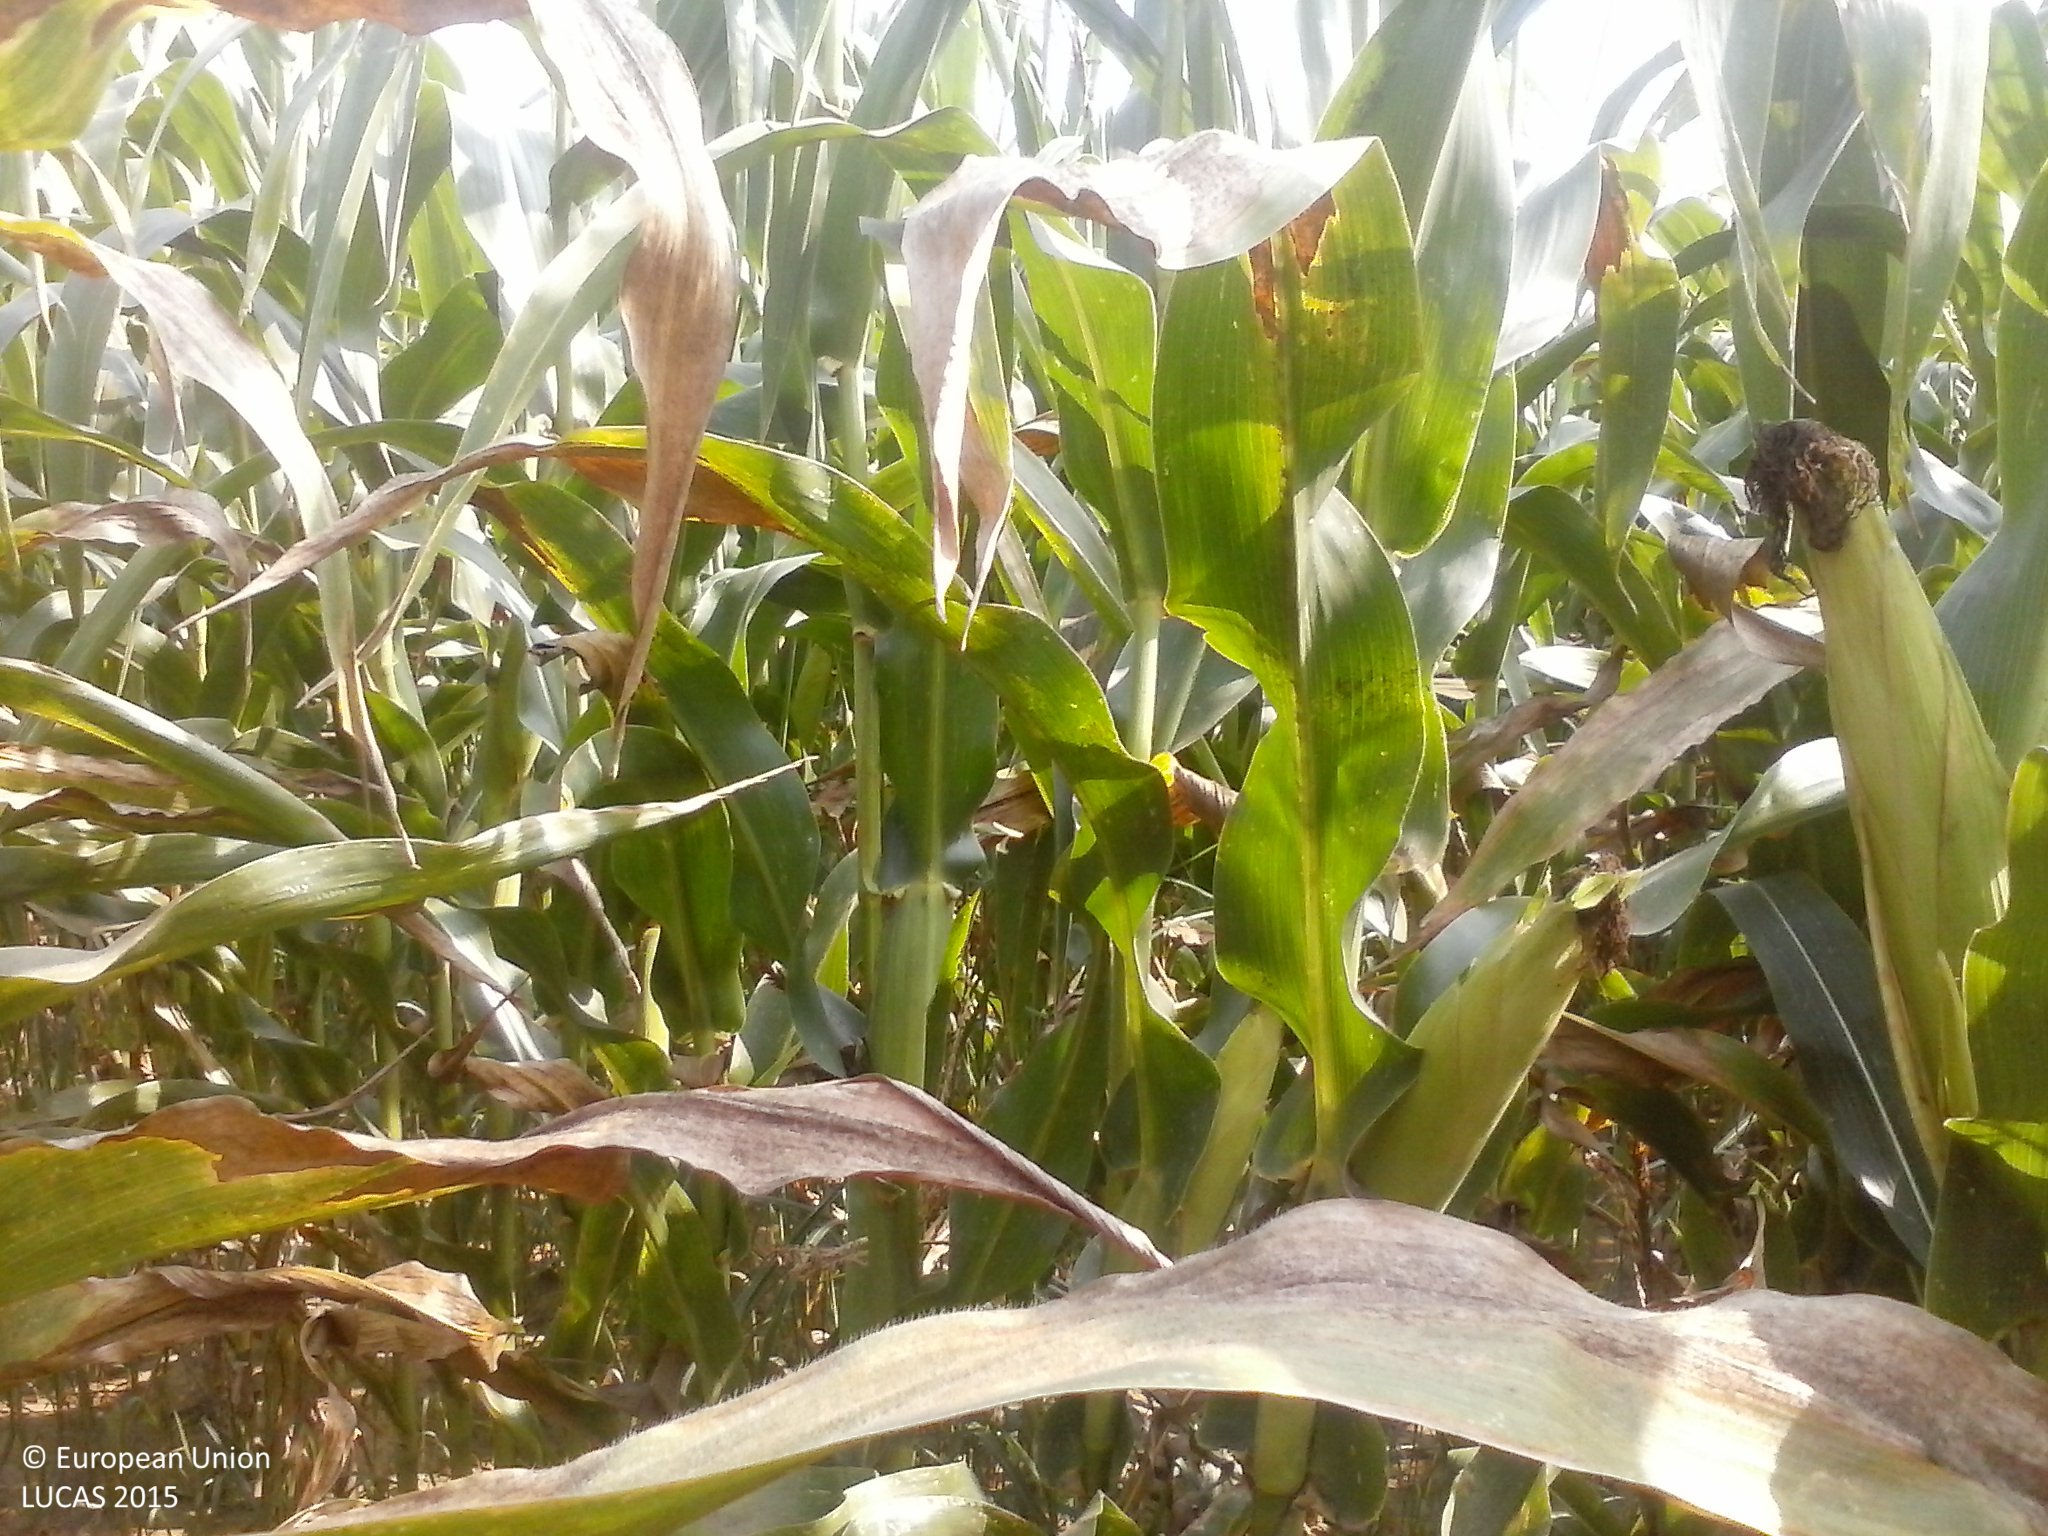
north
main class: Cropland
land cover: Maize
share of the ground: > 75 %
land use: Agriculture (excluding fallow land and kitchen gardens)
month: August
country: HU
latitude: 46.1895
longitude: 17.8443
